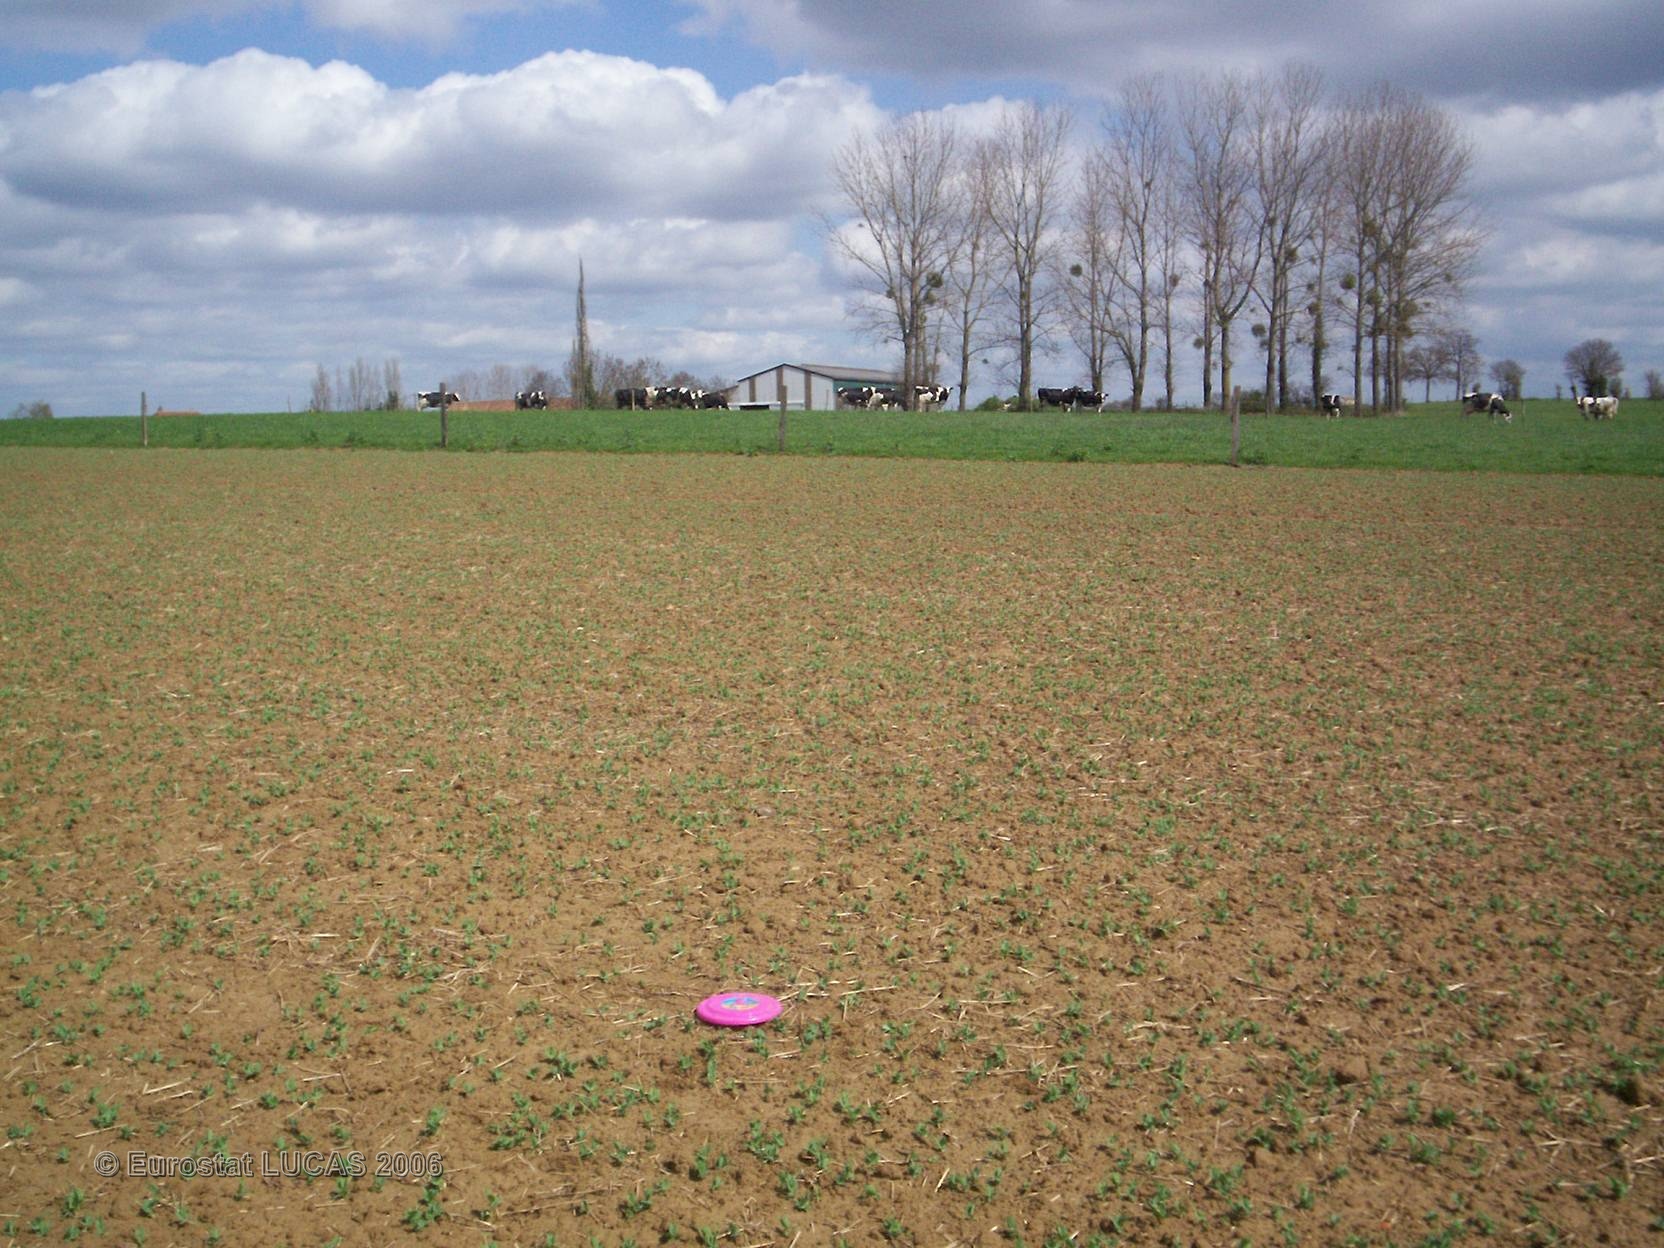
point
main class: Cropland
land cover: Dry pulses
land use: Agriculture (excluding fallow land and kitchen gardens)
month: April
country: FR
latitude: 48.2780
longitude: 0.2309
